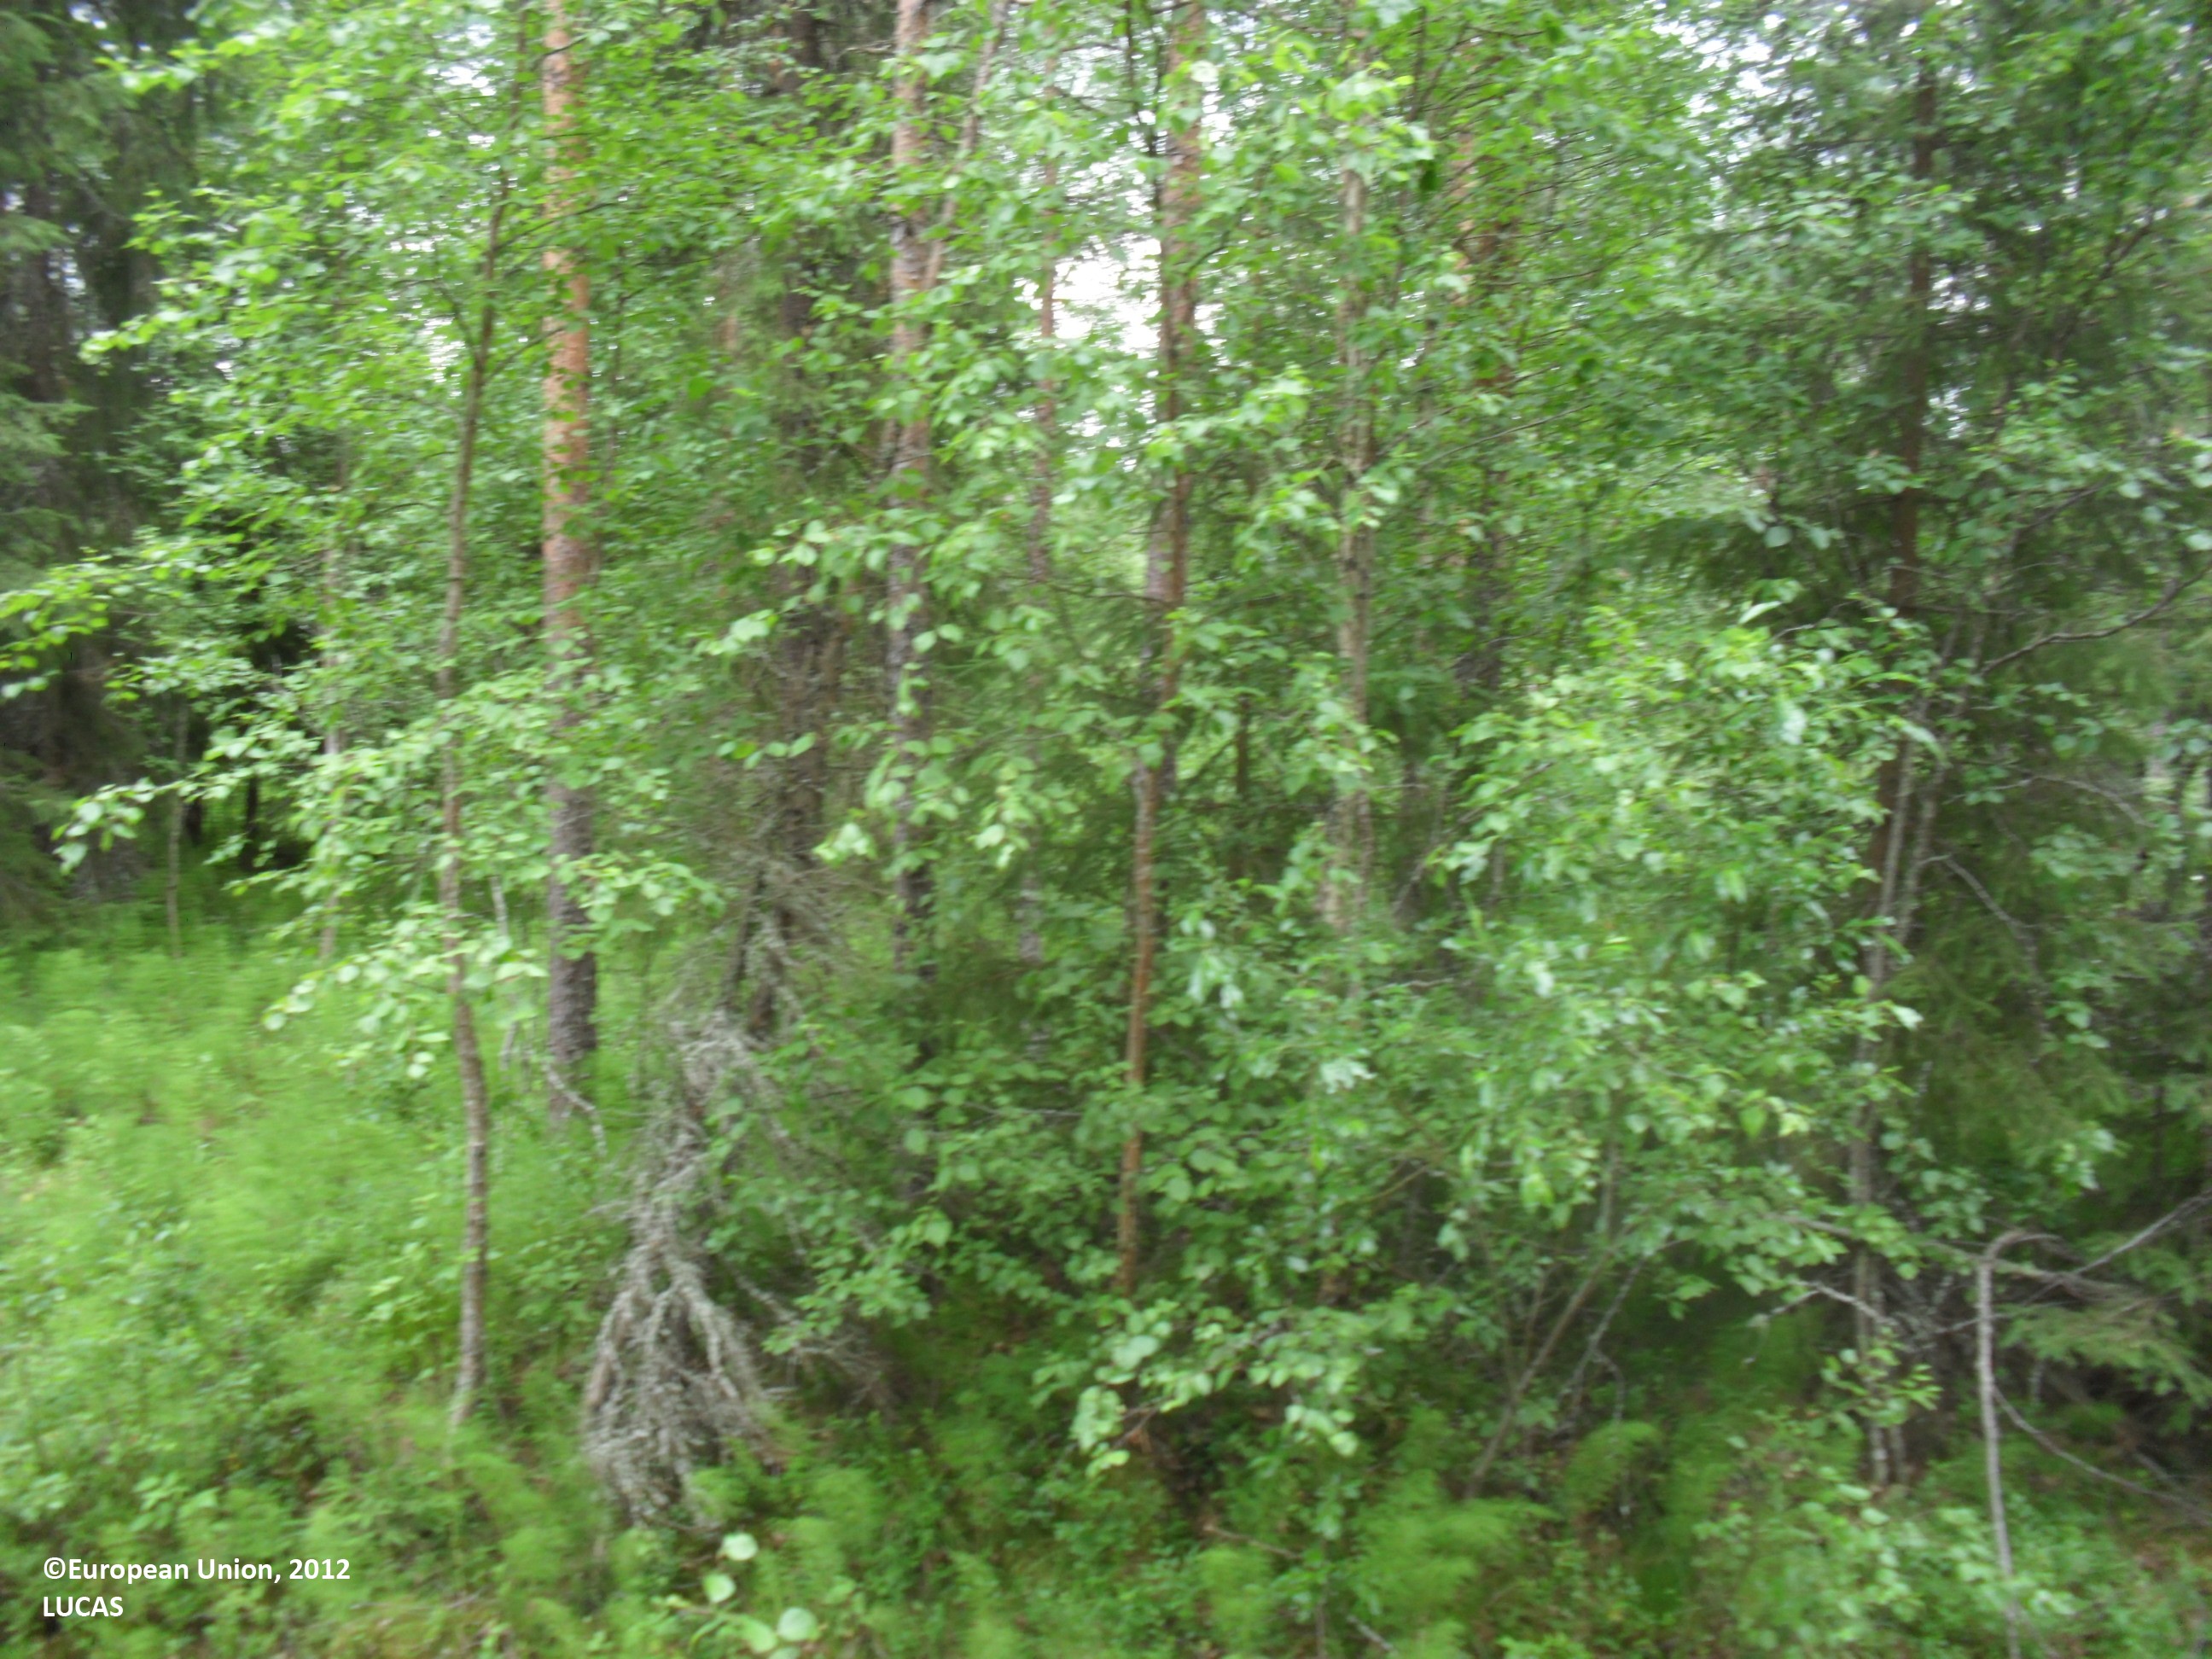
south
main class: Woodland
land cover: Other mixed woodland
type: boreal forest
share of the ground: 25 - 50 %
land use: Forestry
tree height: > 5 m
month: July
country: FI
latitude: 63.6182
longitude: 23.4742
